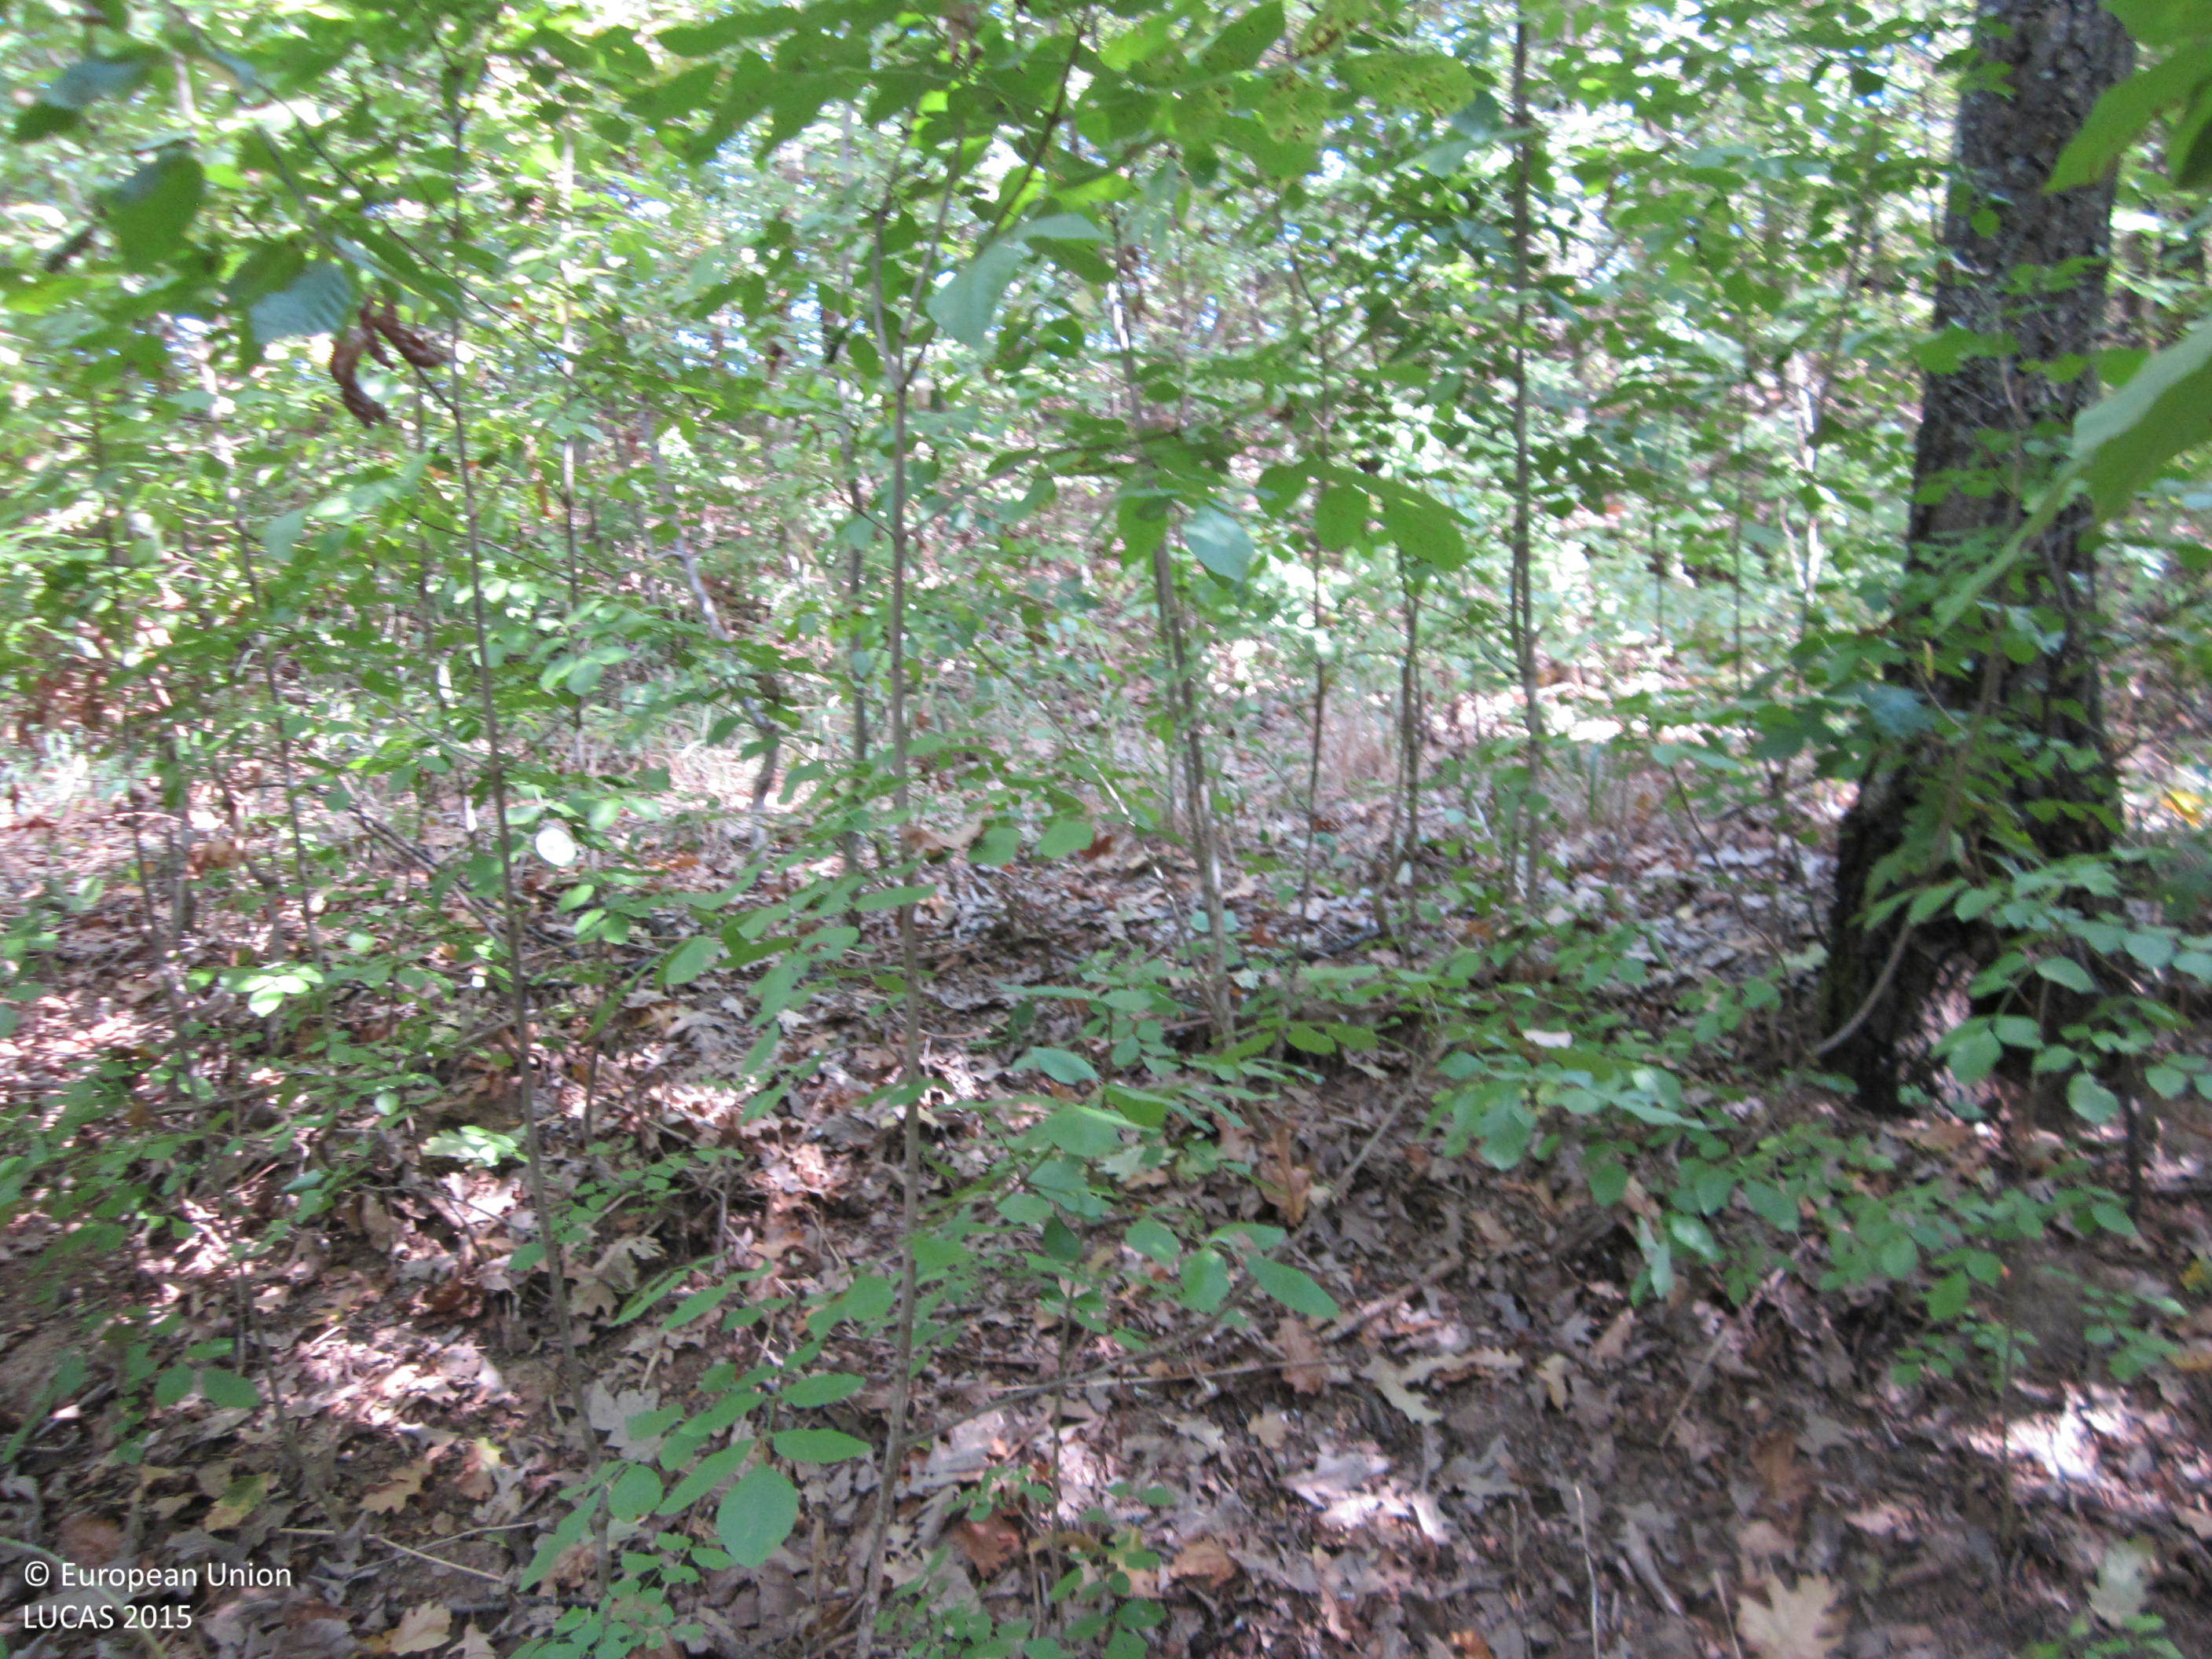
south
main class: Woodland
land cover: Broadleaved woodland
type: mesophytic deciduous forest
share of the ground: > 75 %
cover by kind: broadleaved forest trees 90 %, shrubs 5 %, unconsolidated bare surface 5 %
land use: Forestry
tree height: > 5 m
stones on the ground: < 10 %
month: September
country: BG
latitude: 42.8042
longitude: 27.1209
